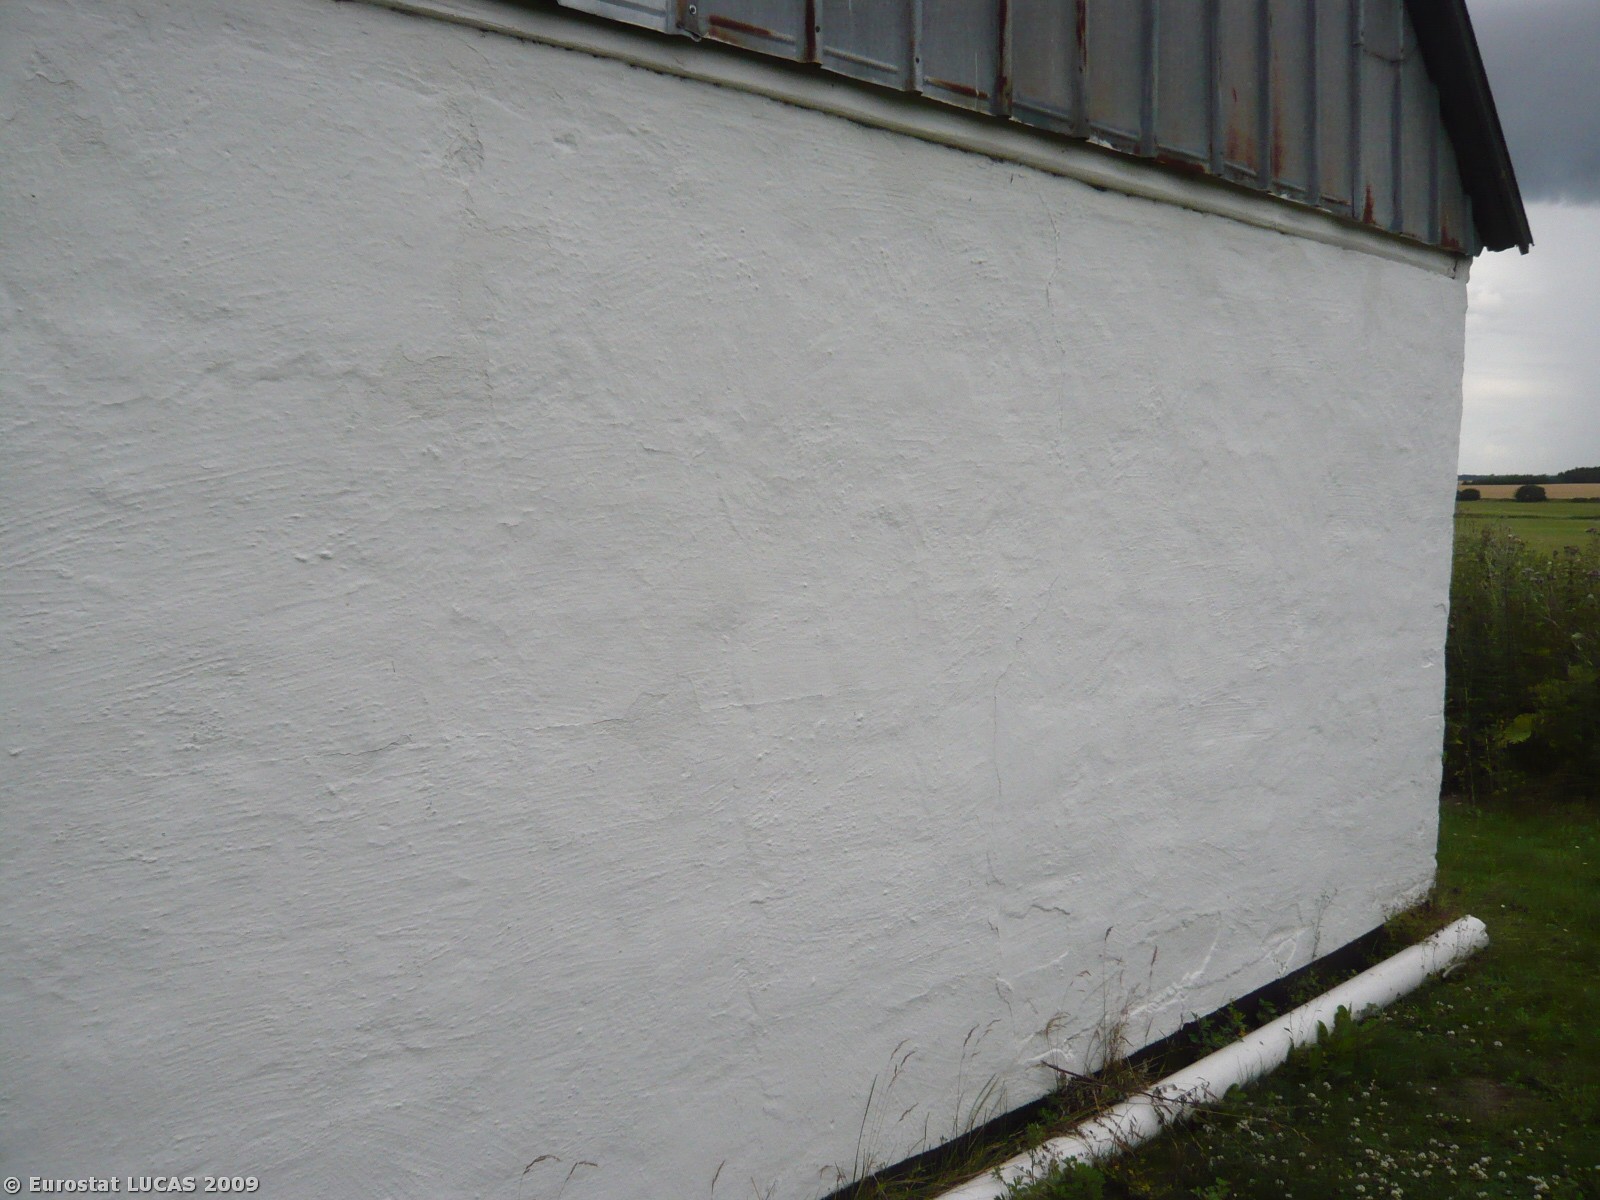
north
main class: Grassland
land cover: Grassland without tree/shrub cover
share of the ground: > 75 %
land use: Agriculture (excluding fallow land and kitchen gardens)
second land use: Amenities, museums, leisure
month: July
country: DK
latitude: 55.5607
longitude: 12.0119
